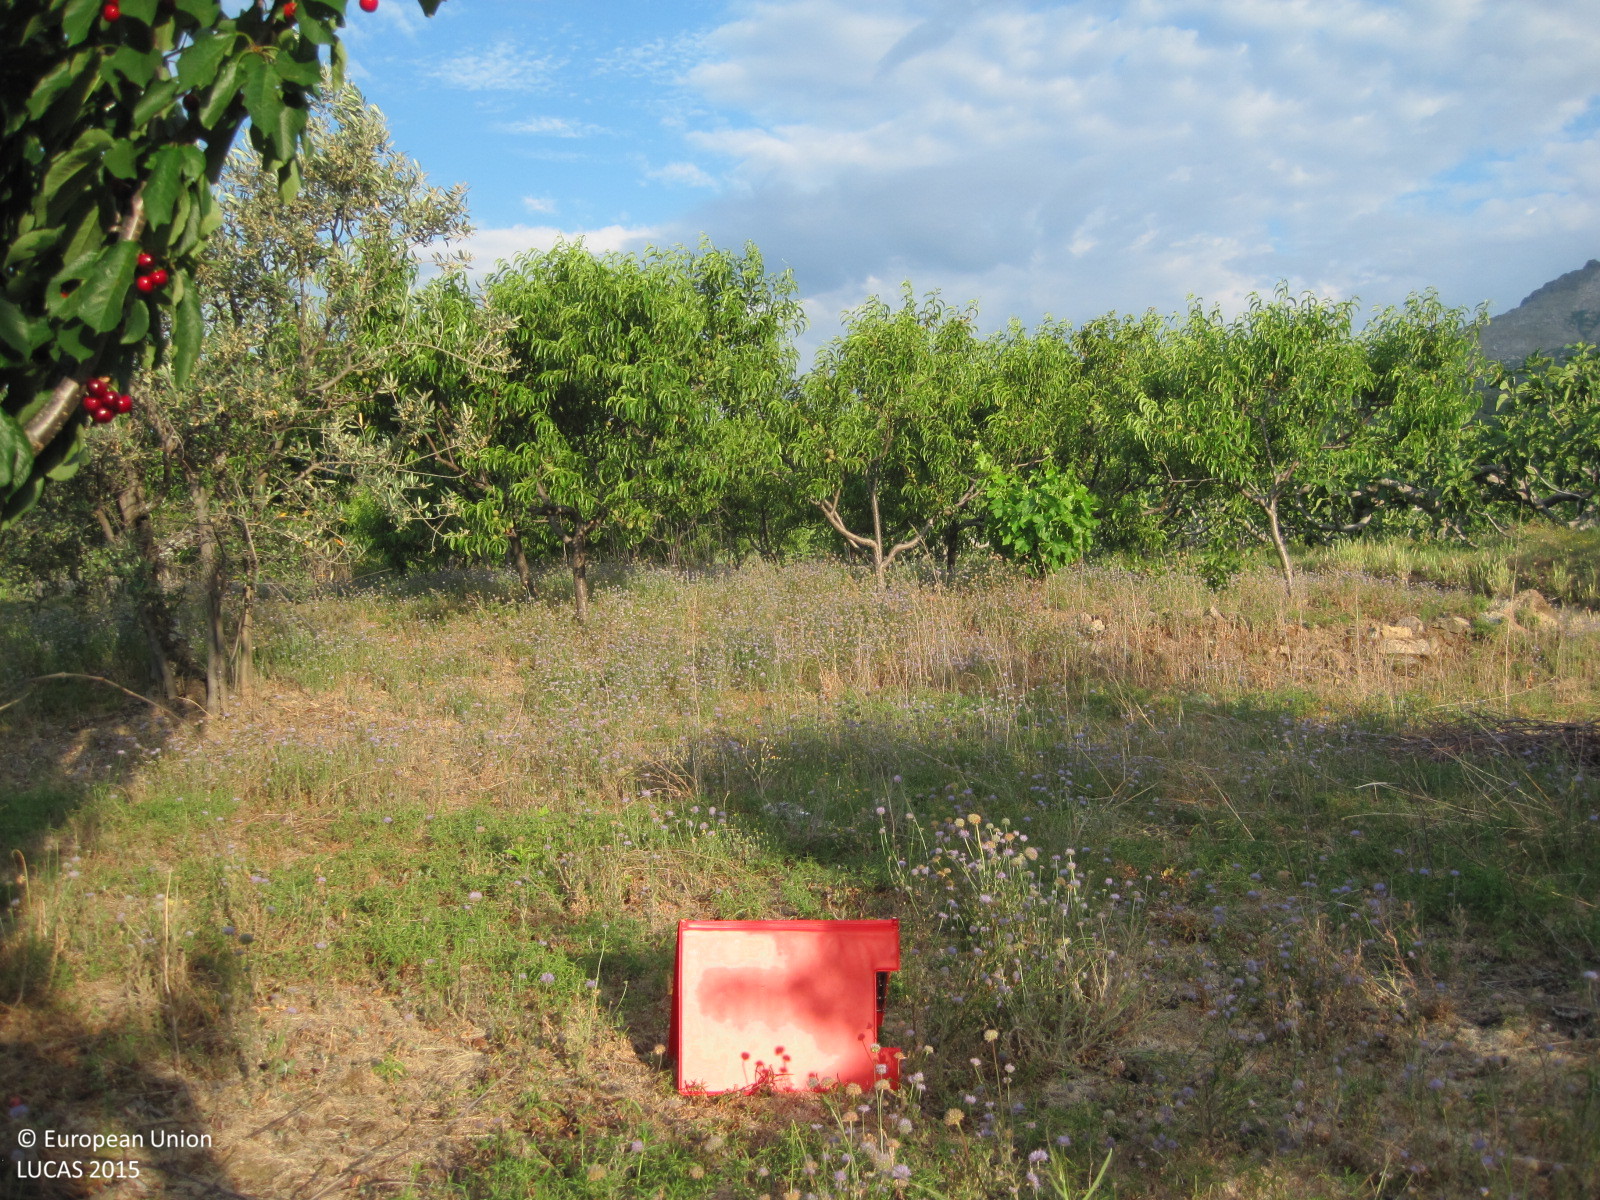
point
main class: Cropland
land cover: Vineyards
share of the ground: 25 - 50 %
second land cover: Nuts trees
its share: 25 - 50 %
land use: Agriculture (excluding fallow land and kitchen gardens)
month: June
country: ES
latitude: 40.2814
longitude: -5.0044
